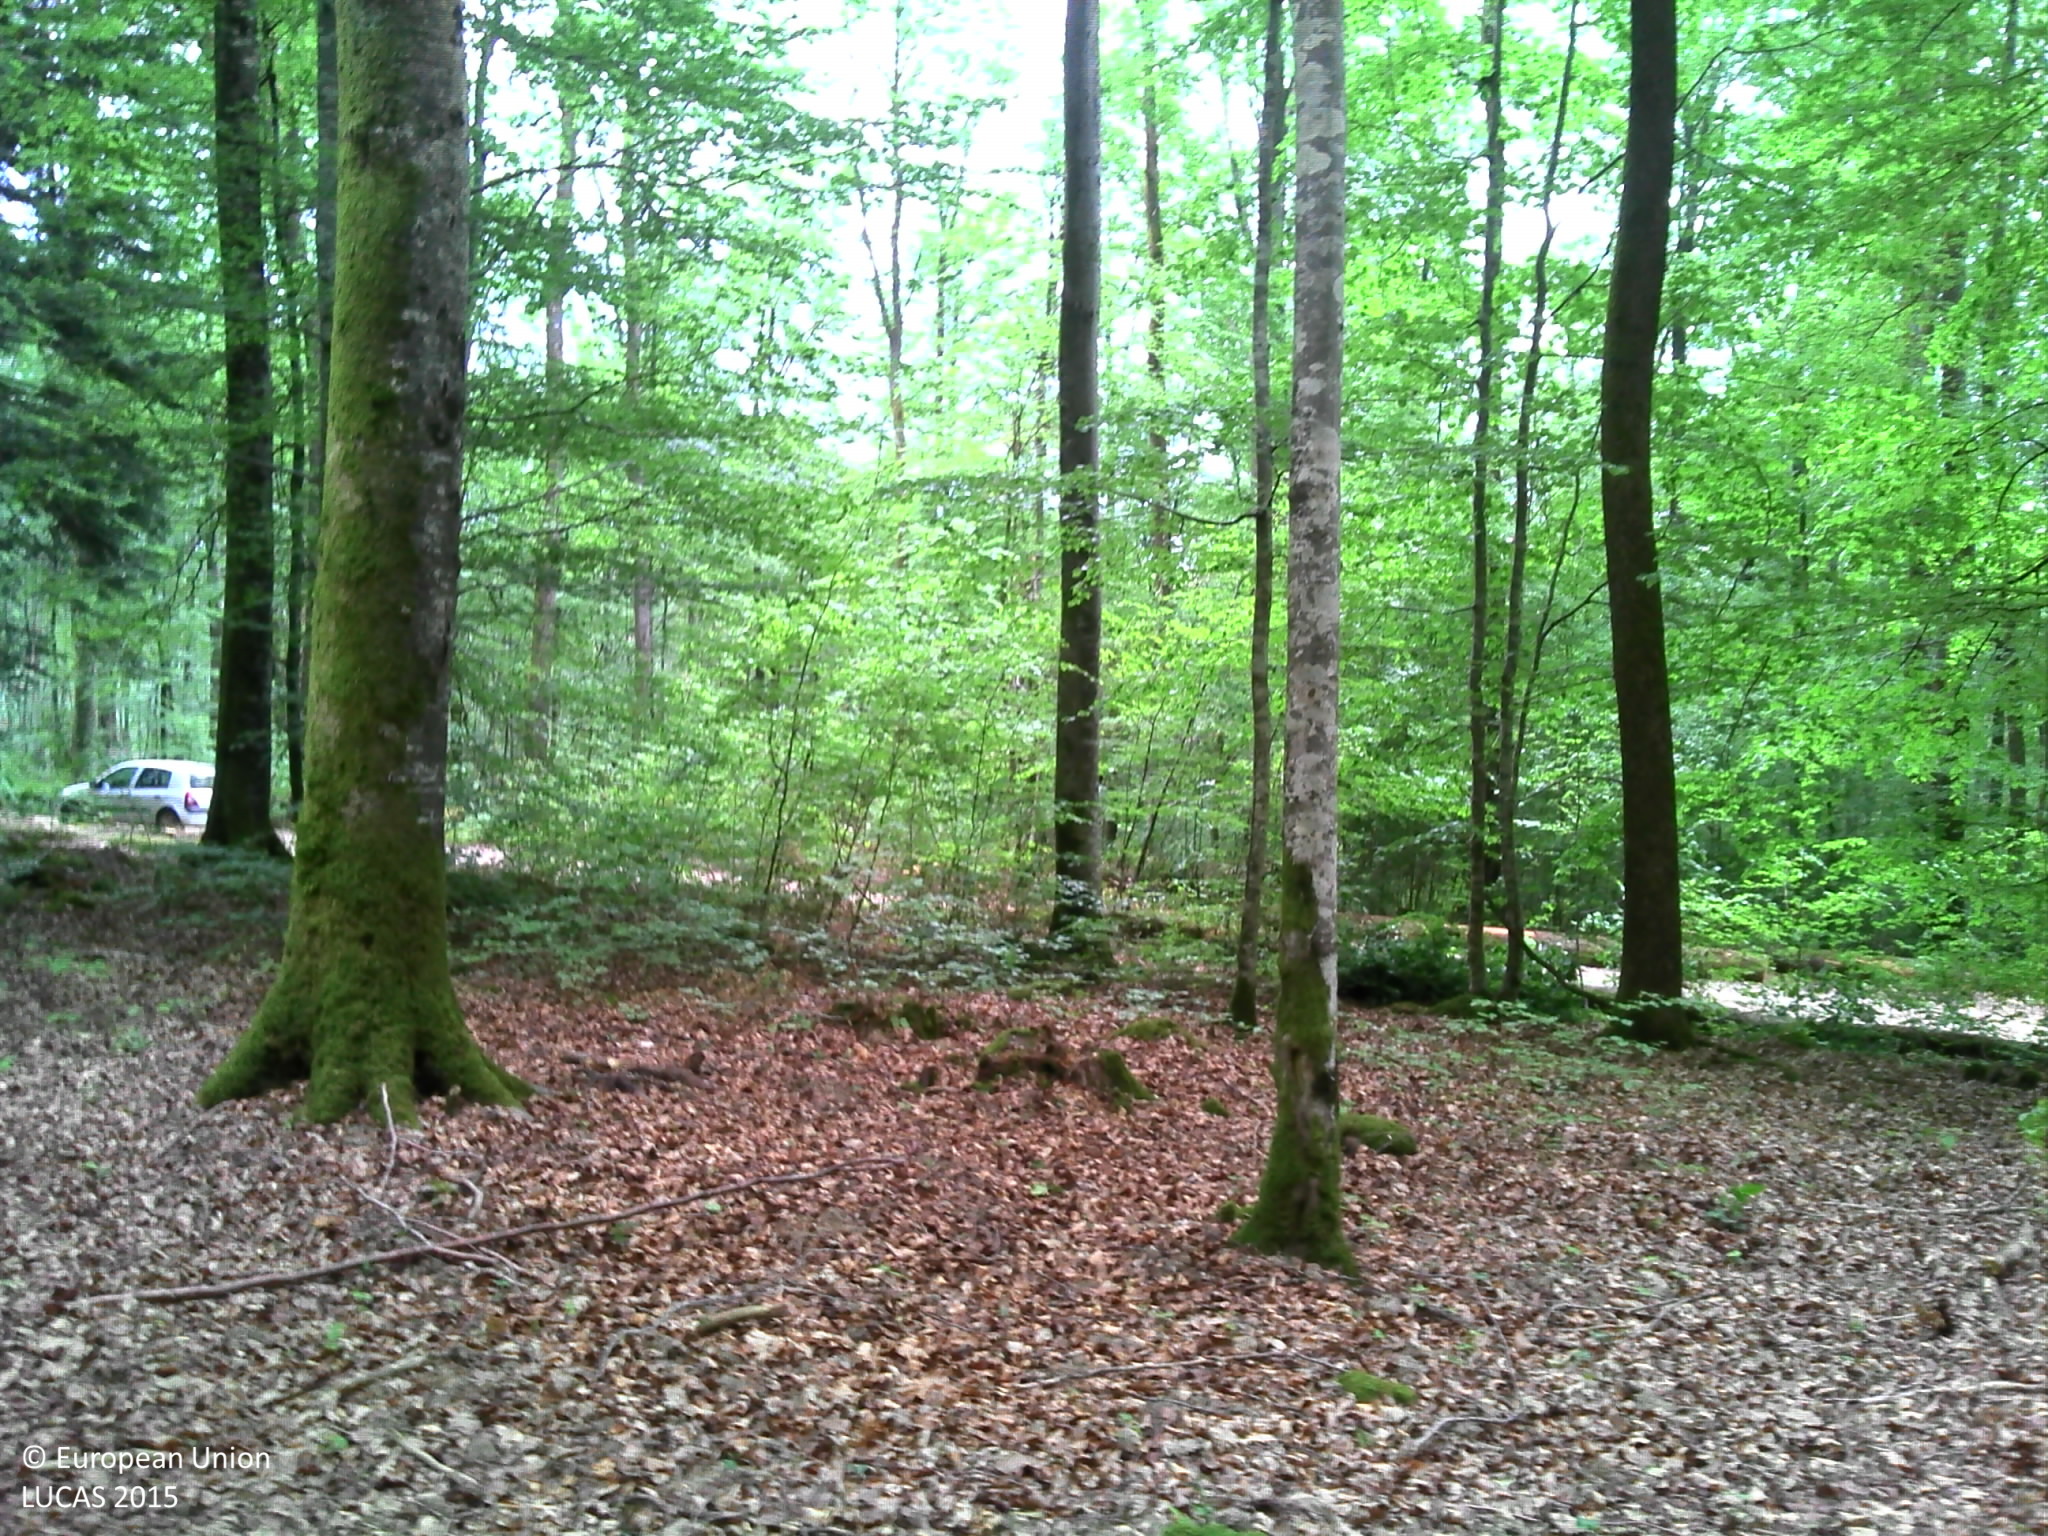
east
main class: Woodland
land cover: Broadleaved woodland
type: beech forest
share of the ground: > 75 %
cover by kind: broadleaved forest trees 90 %, coniferous forest trees 5 %, herbaceous plants 5 %
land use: Forestry
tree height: > 5 m
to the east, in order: Broadleaved woodland; Tracks; Broadleaved woodland; Ponds and wetlands; Broadleaved woodland; Ditches and canals; Broadleaved woodland
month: May
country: FR
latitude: 47.9925
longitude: 6.1011
